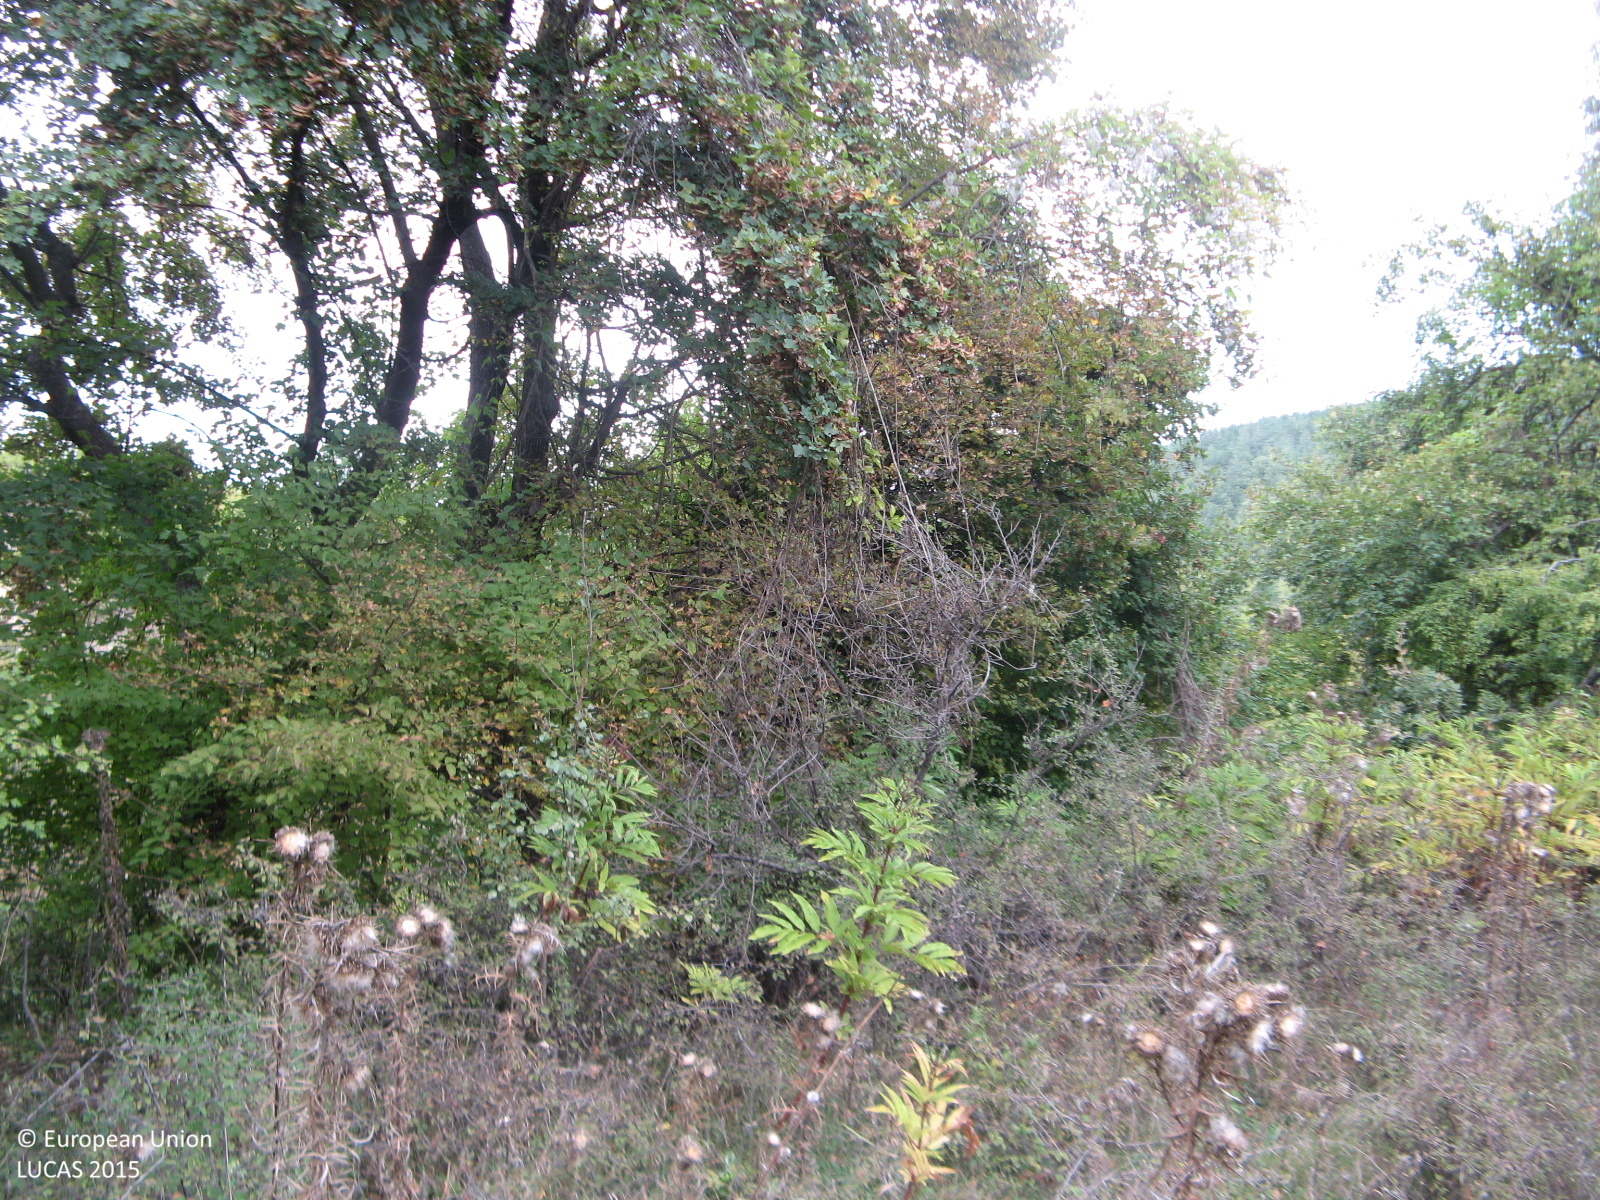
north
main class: Woodland
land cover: Broadleaved woodland
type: thermophilous deciduous forest
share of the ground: > 75 %
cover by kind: broadleaved forest trees 85 %, shrubs 10 %, herbaceous plants 5 %
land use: Semi-natural and natural areas not in use
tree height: > 5 m
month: October
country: BG
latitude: 41.7133
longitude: 25.3577
